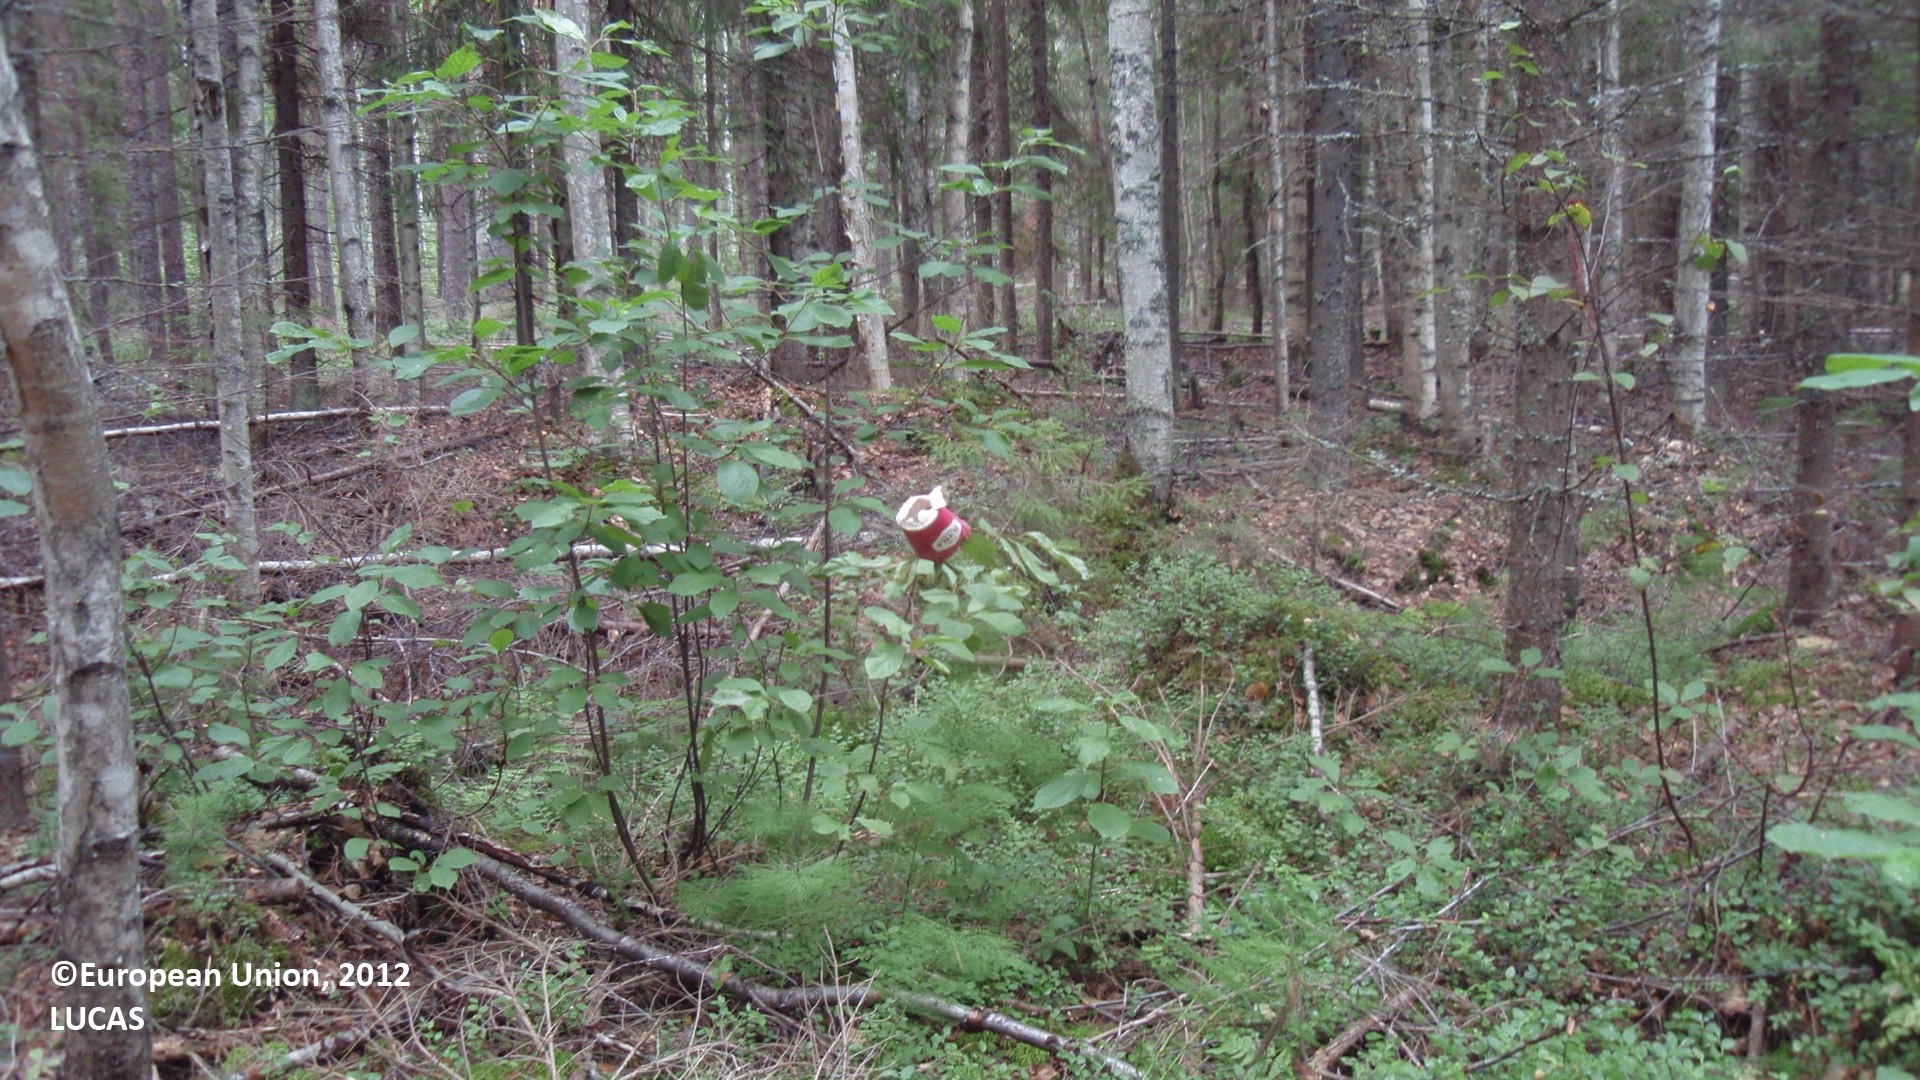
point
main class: Woodland
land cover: Other coniferous woodland
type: boreal forest
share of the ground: > 75 %
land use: Forestry
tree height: > 5 m
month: August
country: FI
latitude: 61.1200
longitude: 27.4217
